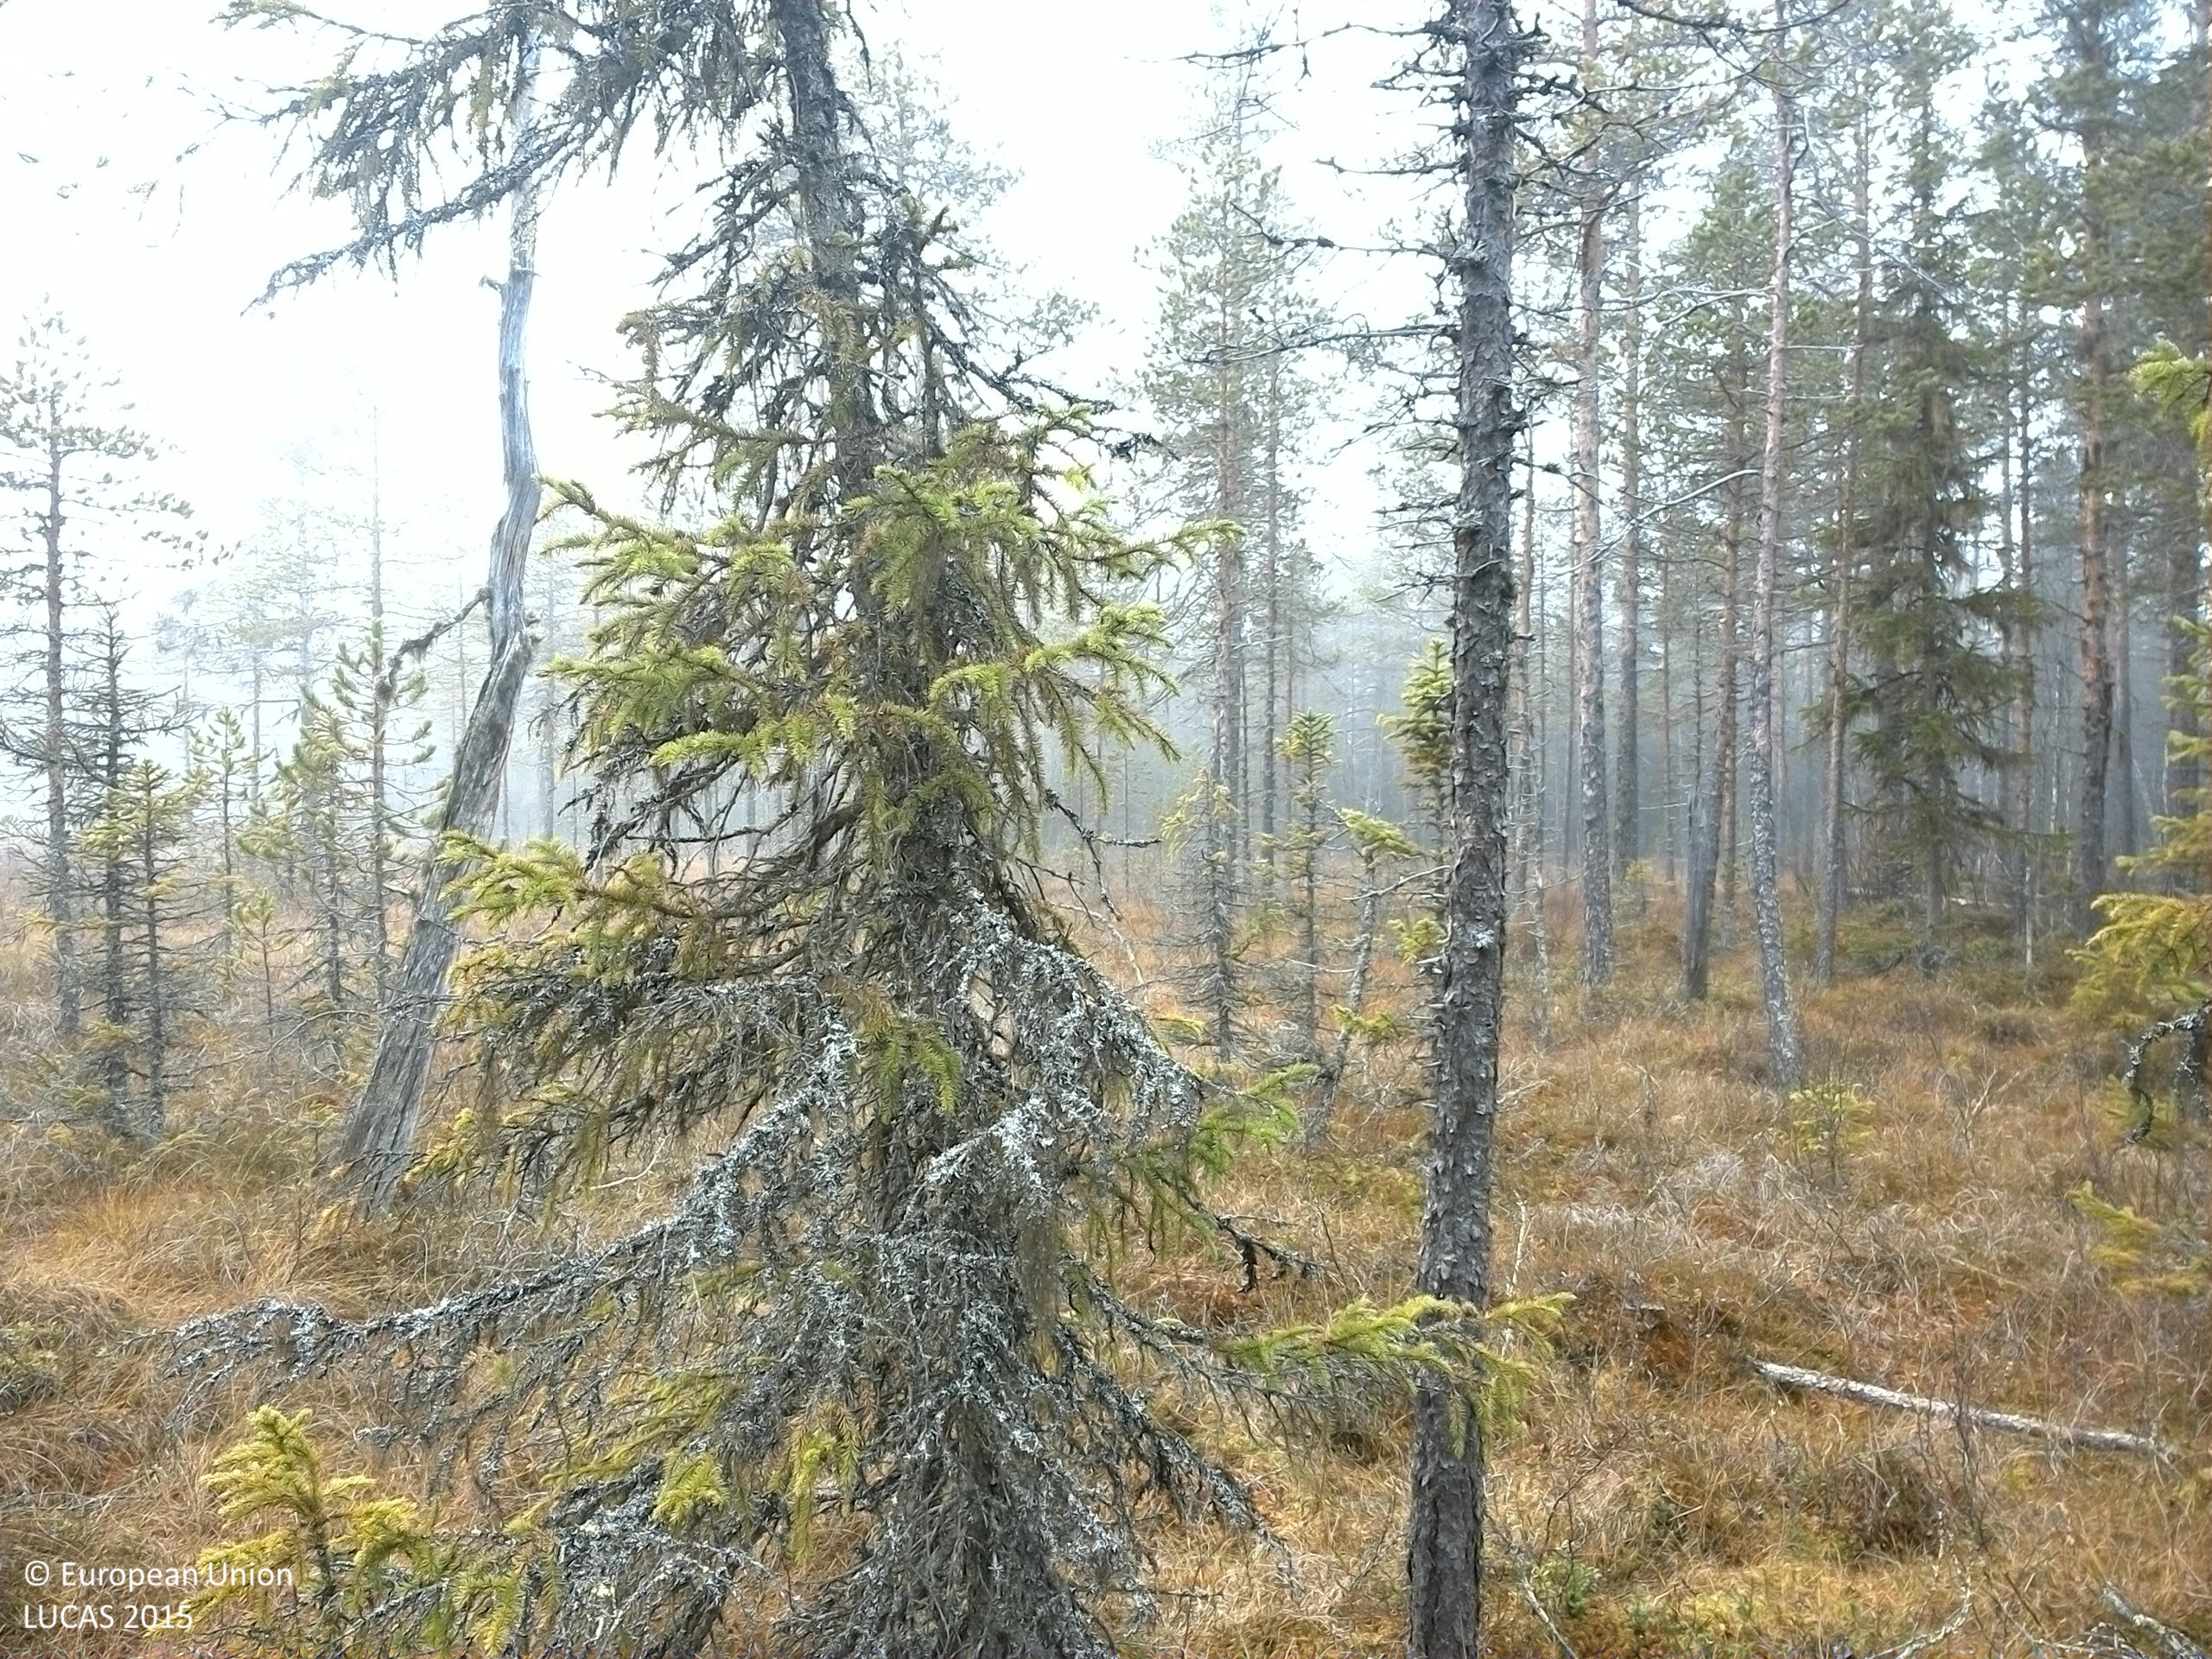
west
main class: Woodland
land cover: Pine dominated coniferous woodland
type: boreal forest
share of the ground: 25 - 50 %
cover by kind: coniferous forest trees 30 %, shrubs 25 %, lichens and mosses 25 %, herbaceous plants 20 %
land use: Forestry
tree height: > 5 m
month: October
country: SE
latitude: 64.0523
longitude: 16.3822
